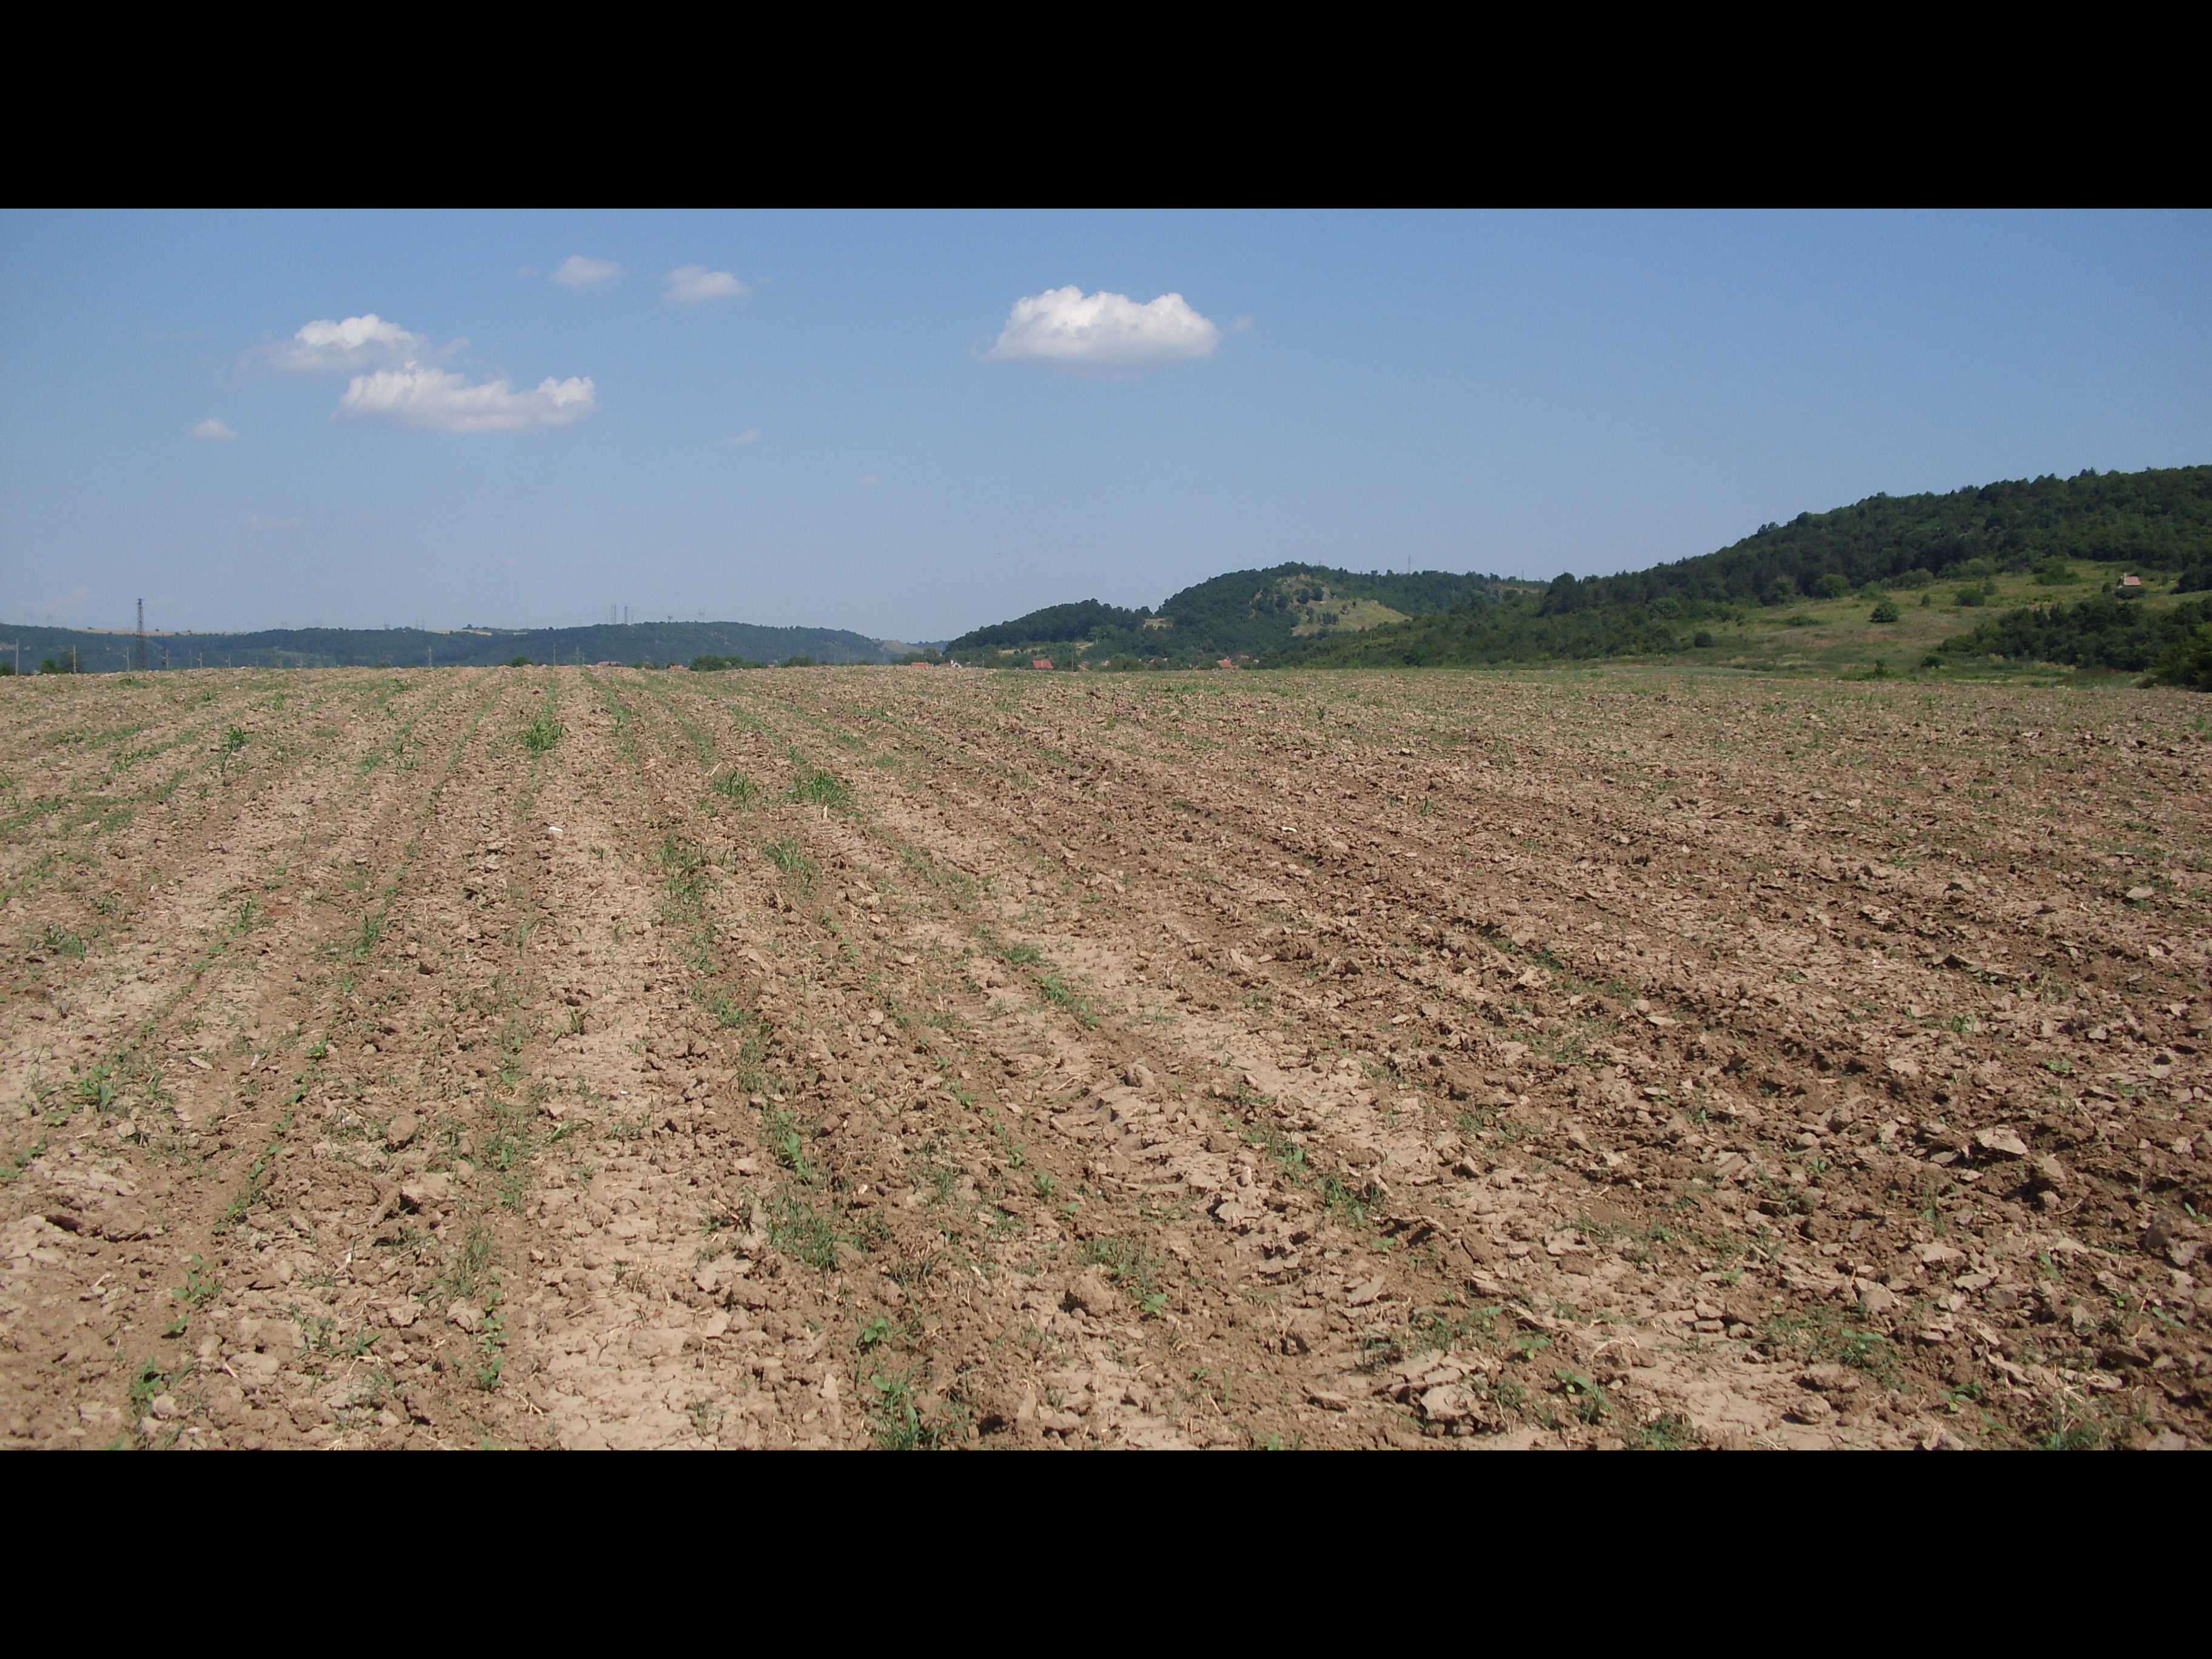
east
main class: Cropland
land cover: Sunflower
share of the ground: < 10 %
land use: Agriculture (excluding fallow land and kitchen gardens)
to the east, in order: Sunflower
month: June
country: BG
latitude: 43.4711
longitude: 23.3054
